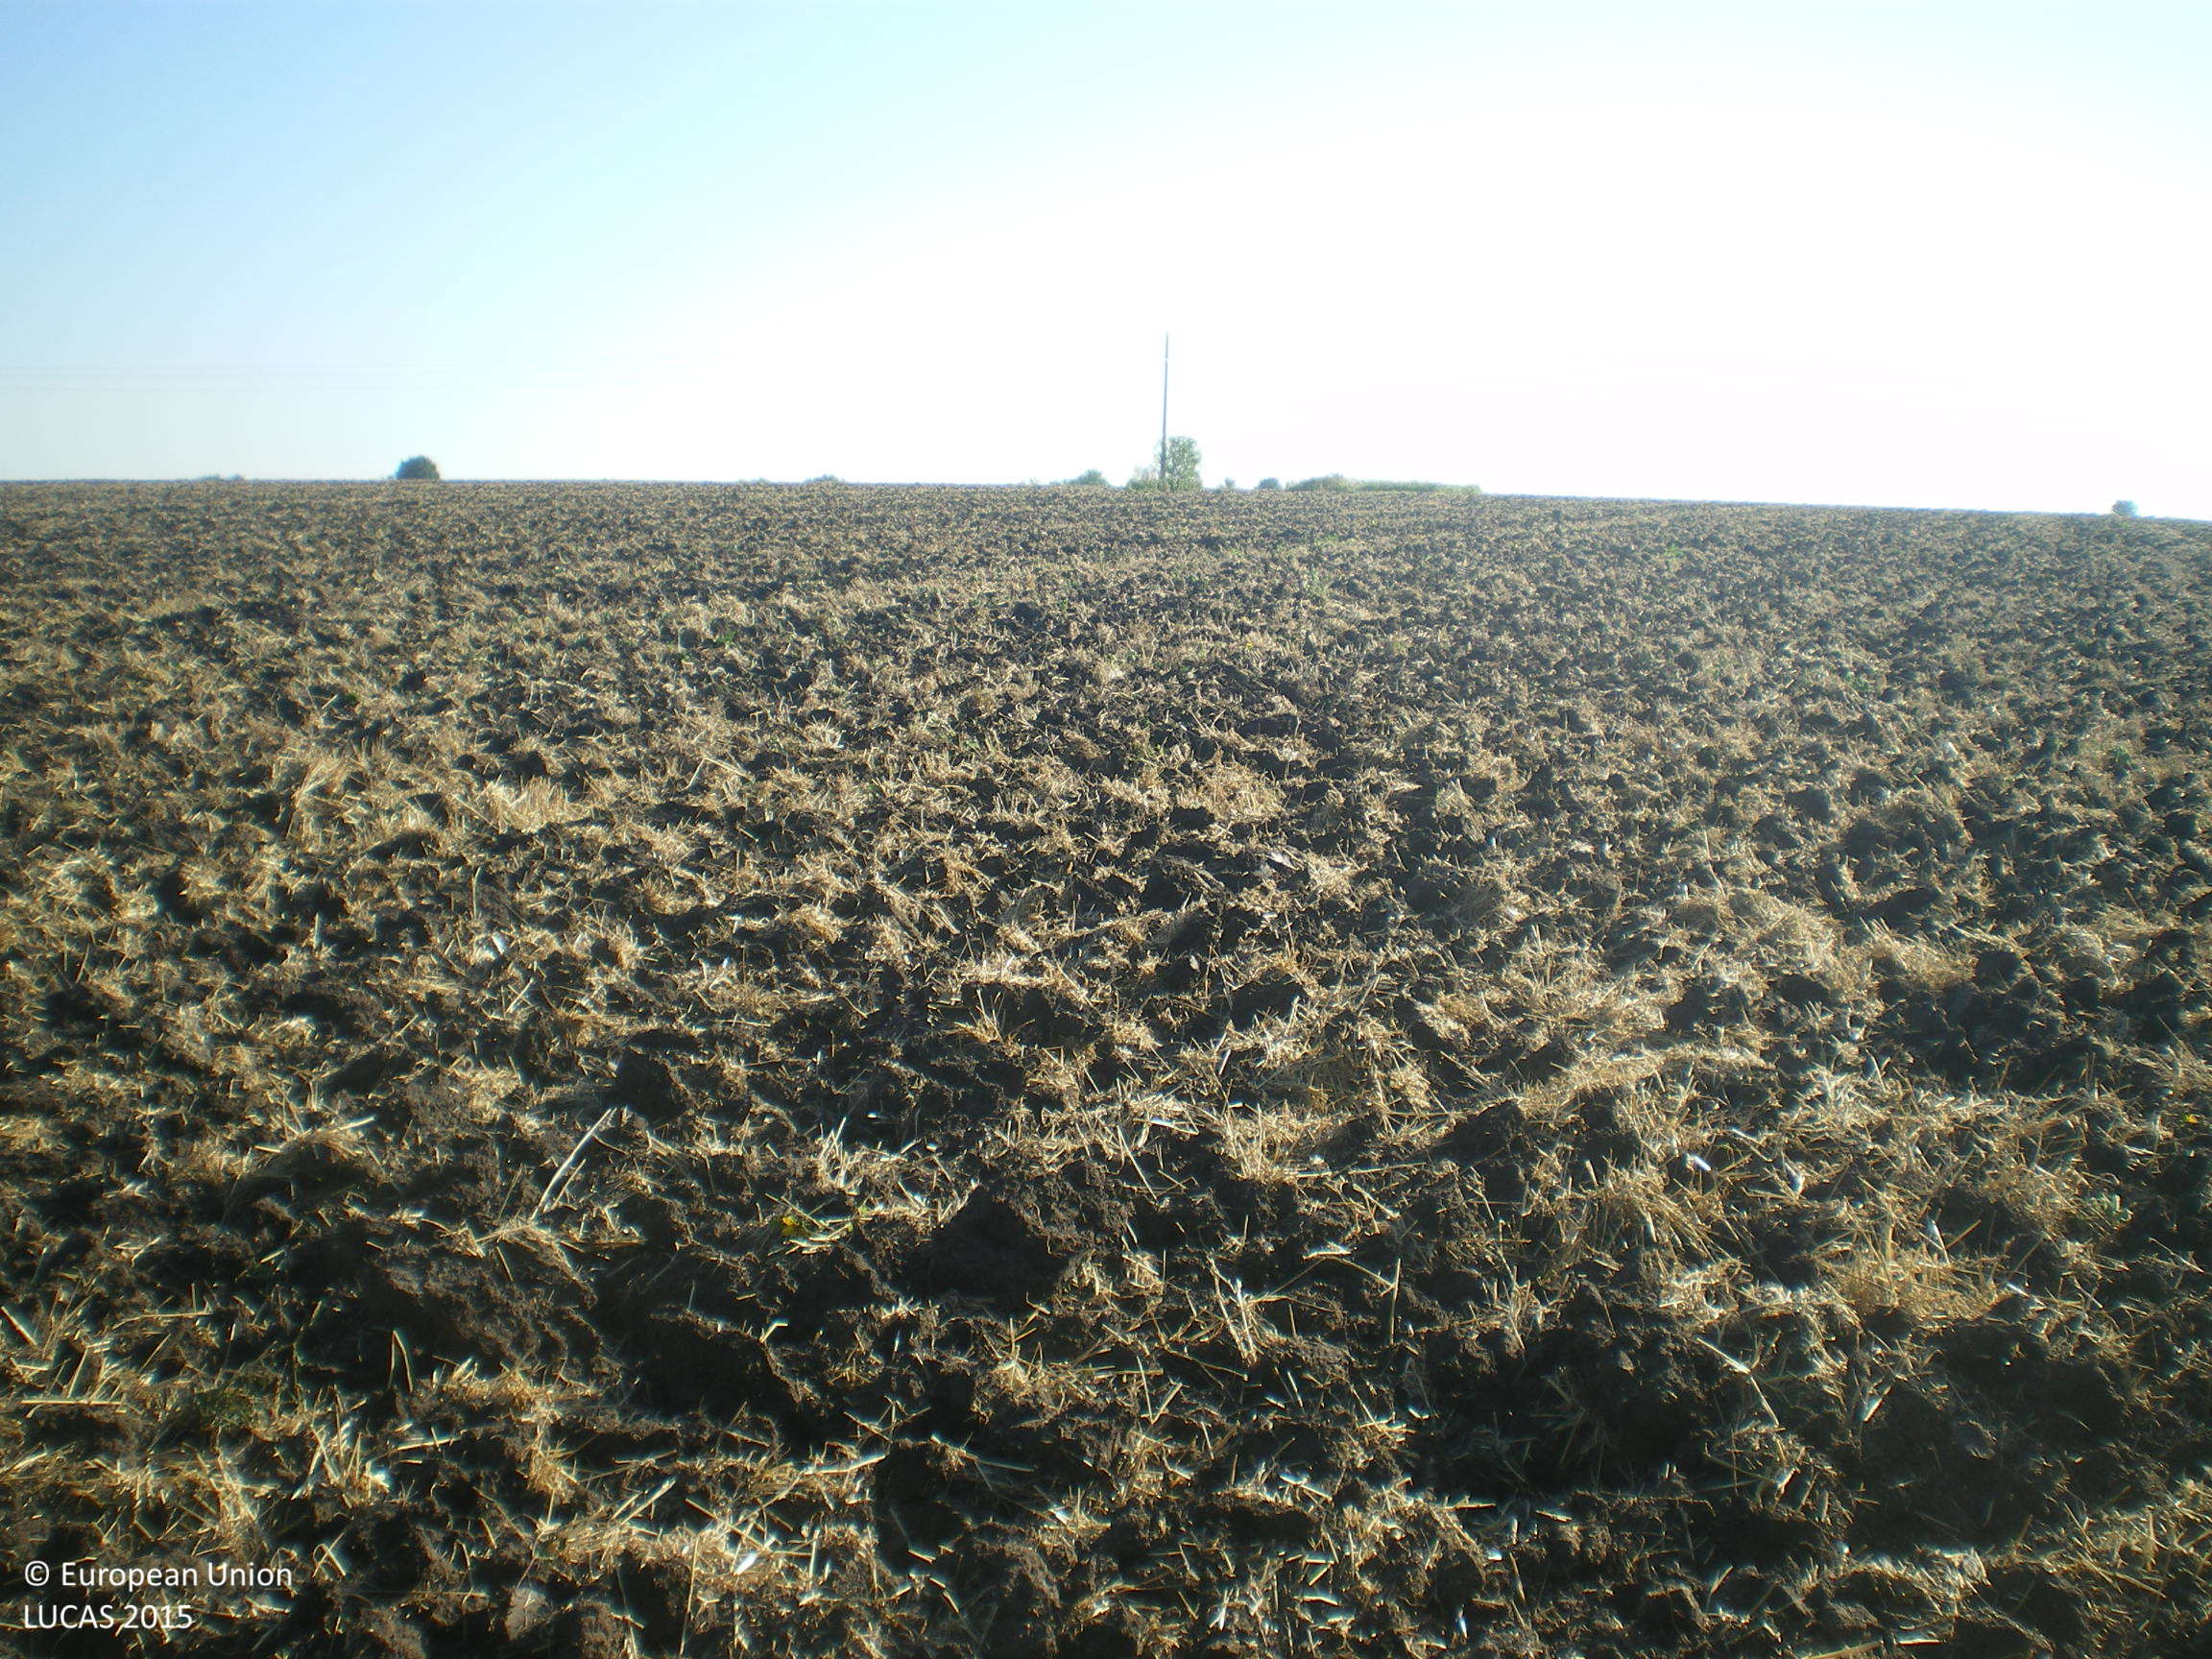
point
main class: Cropland
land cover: Common wheat
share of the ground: < 10 %
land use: Agriculture (excluding fallow land and kitchen gardens)
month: July
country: BG
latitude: 42.0718
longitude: 25.6472
